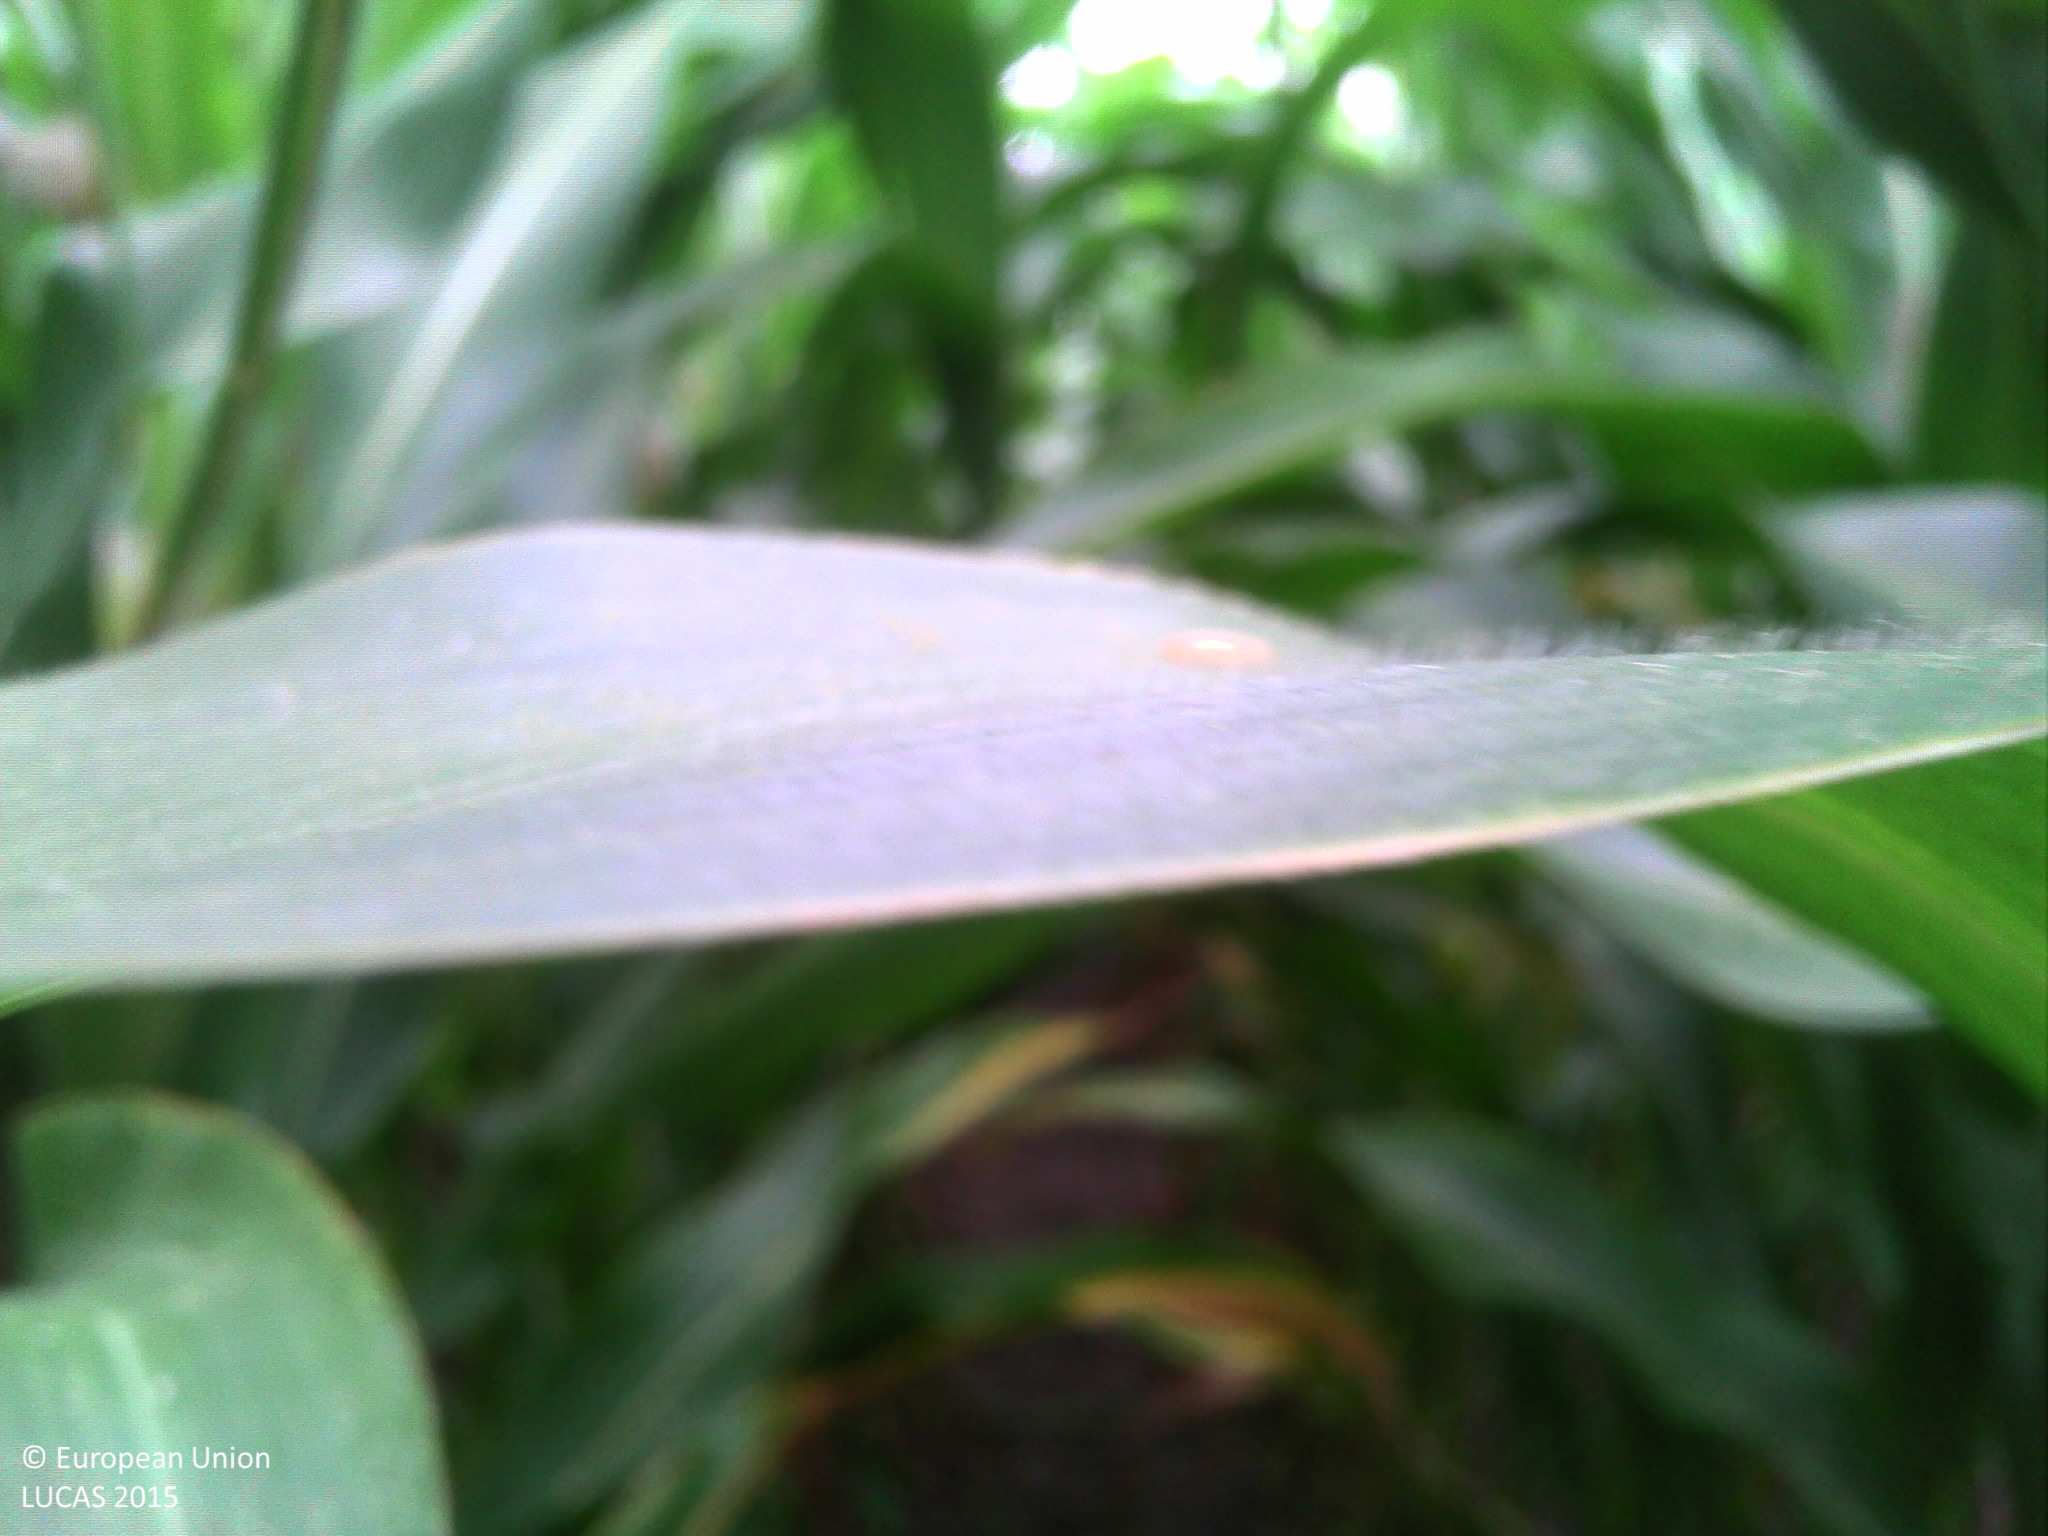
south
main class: Cropland
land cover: Maize
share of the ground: > 75 %
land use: Agriculture (excluding fallow land and kitchen gardens)
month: July
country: FR
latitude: 48.1697
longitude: 3.3919
